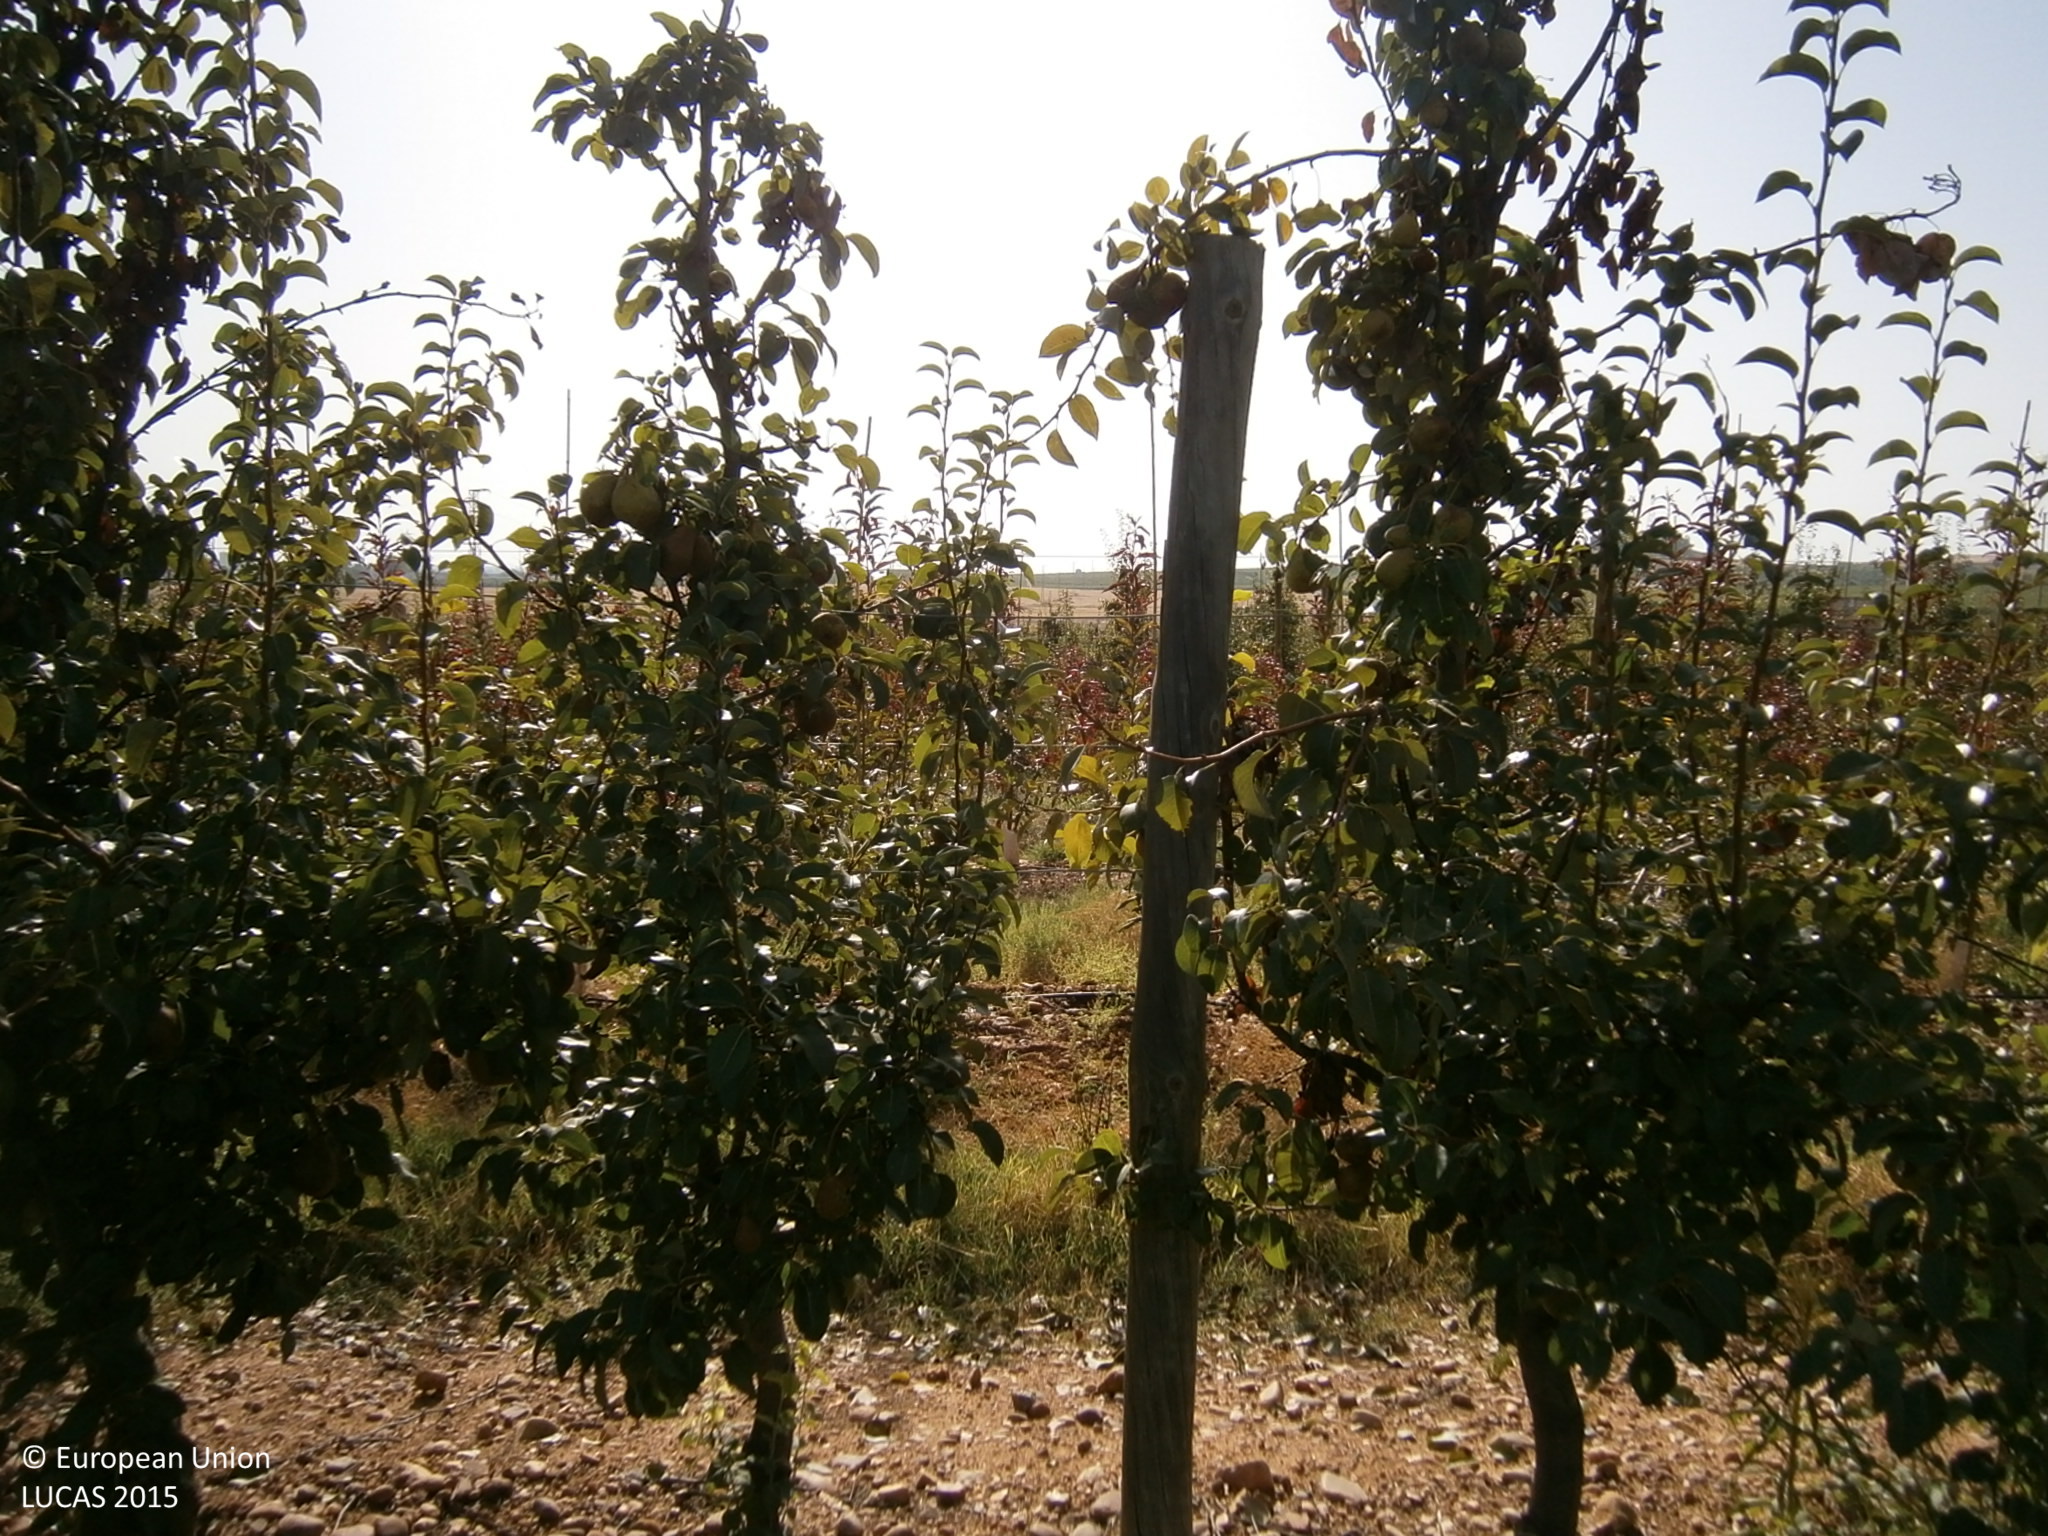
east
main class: Cropland
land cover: Pear fruit
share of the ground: 25 - 50 %
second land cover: Spontaneously vegetated surfaces
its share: 25 - 50 %
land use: Agriculture (excluding fallow land and kitchen gardens)
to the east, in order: Pear fruit; Spontaneously vegetated surfaces; Lines of trees; Tracks; Spontaneously vegetated surfaces; Rivers and streams
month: July
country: ES
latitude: 38.8740
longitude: -6.8377
